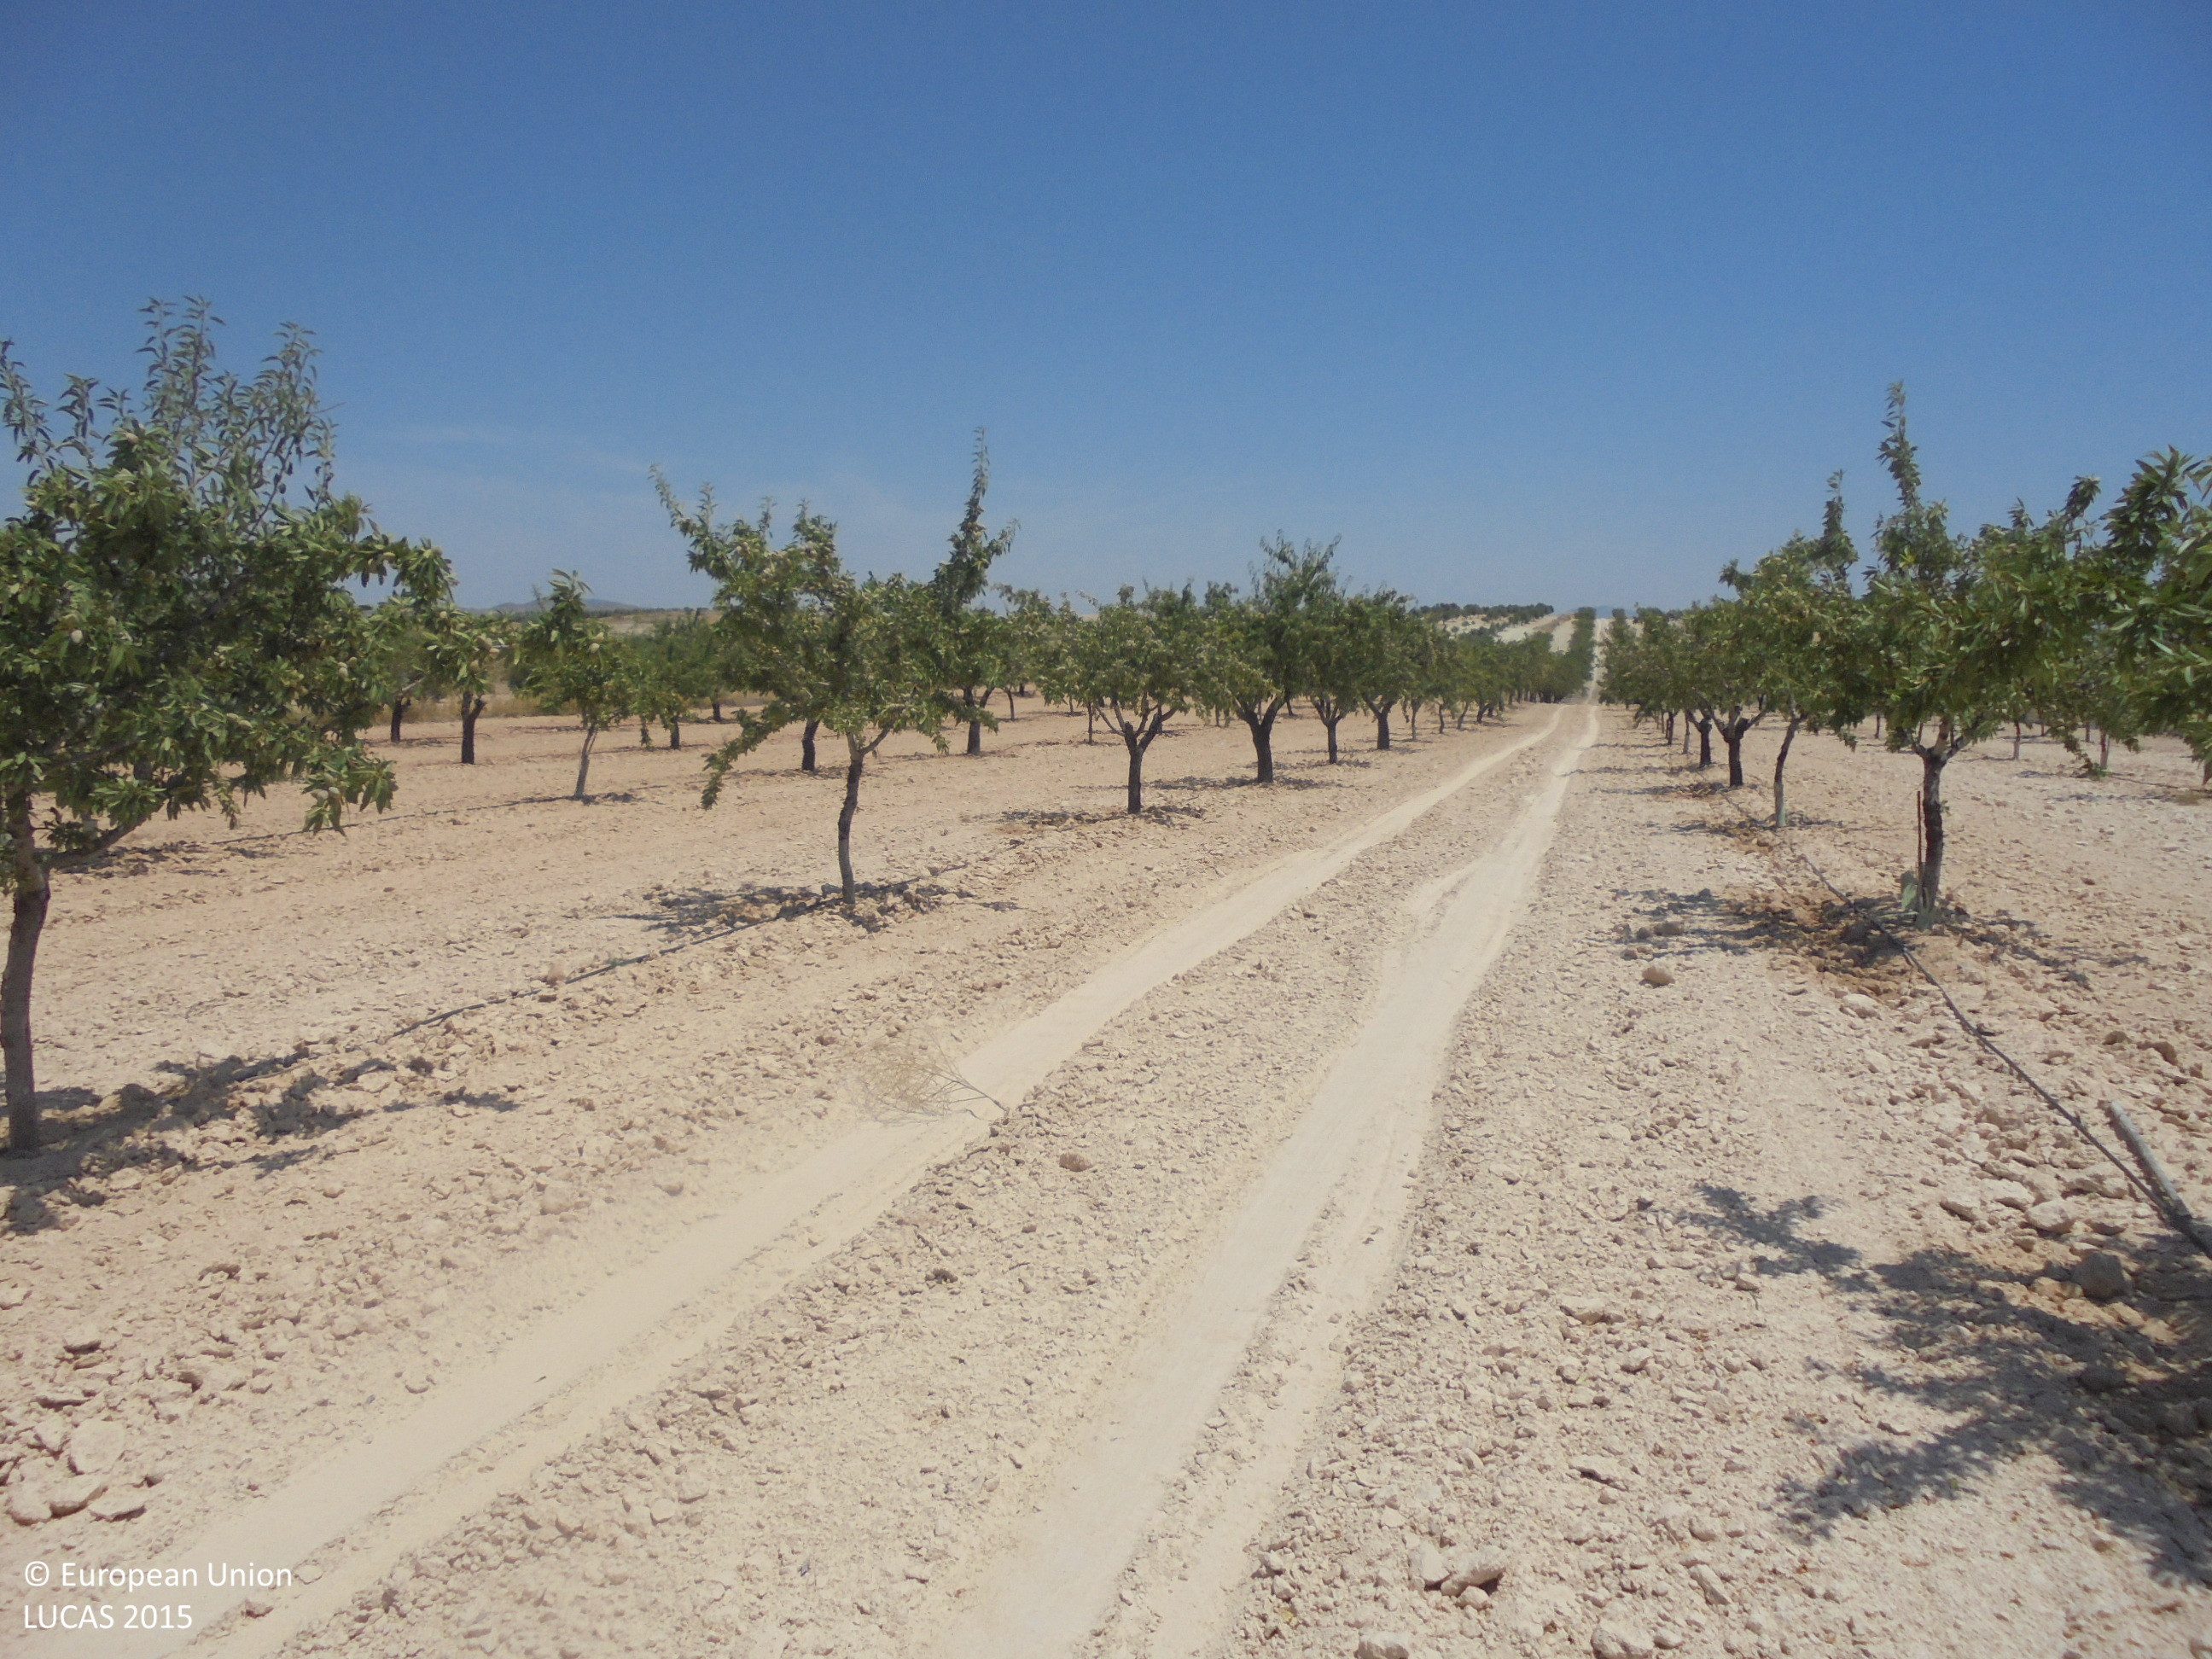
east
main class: Cropland
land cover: Nuts trees
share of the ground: 10 - 25 %
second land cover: Other bare soil
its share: > 75 %
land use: Agriculture (excluding fallow land and kitchen gardens)
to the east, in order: Nuts trees; Other bare soil; Grass margins; Dry stone walls; Grass margins; Olive groves
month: July
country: ES
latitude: 38.5982
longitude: -1.5328
